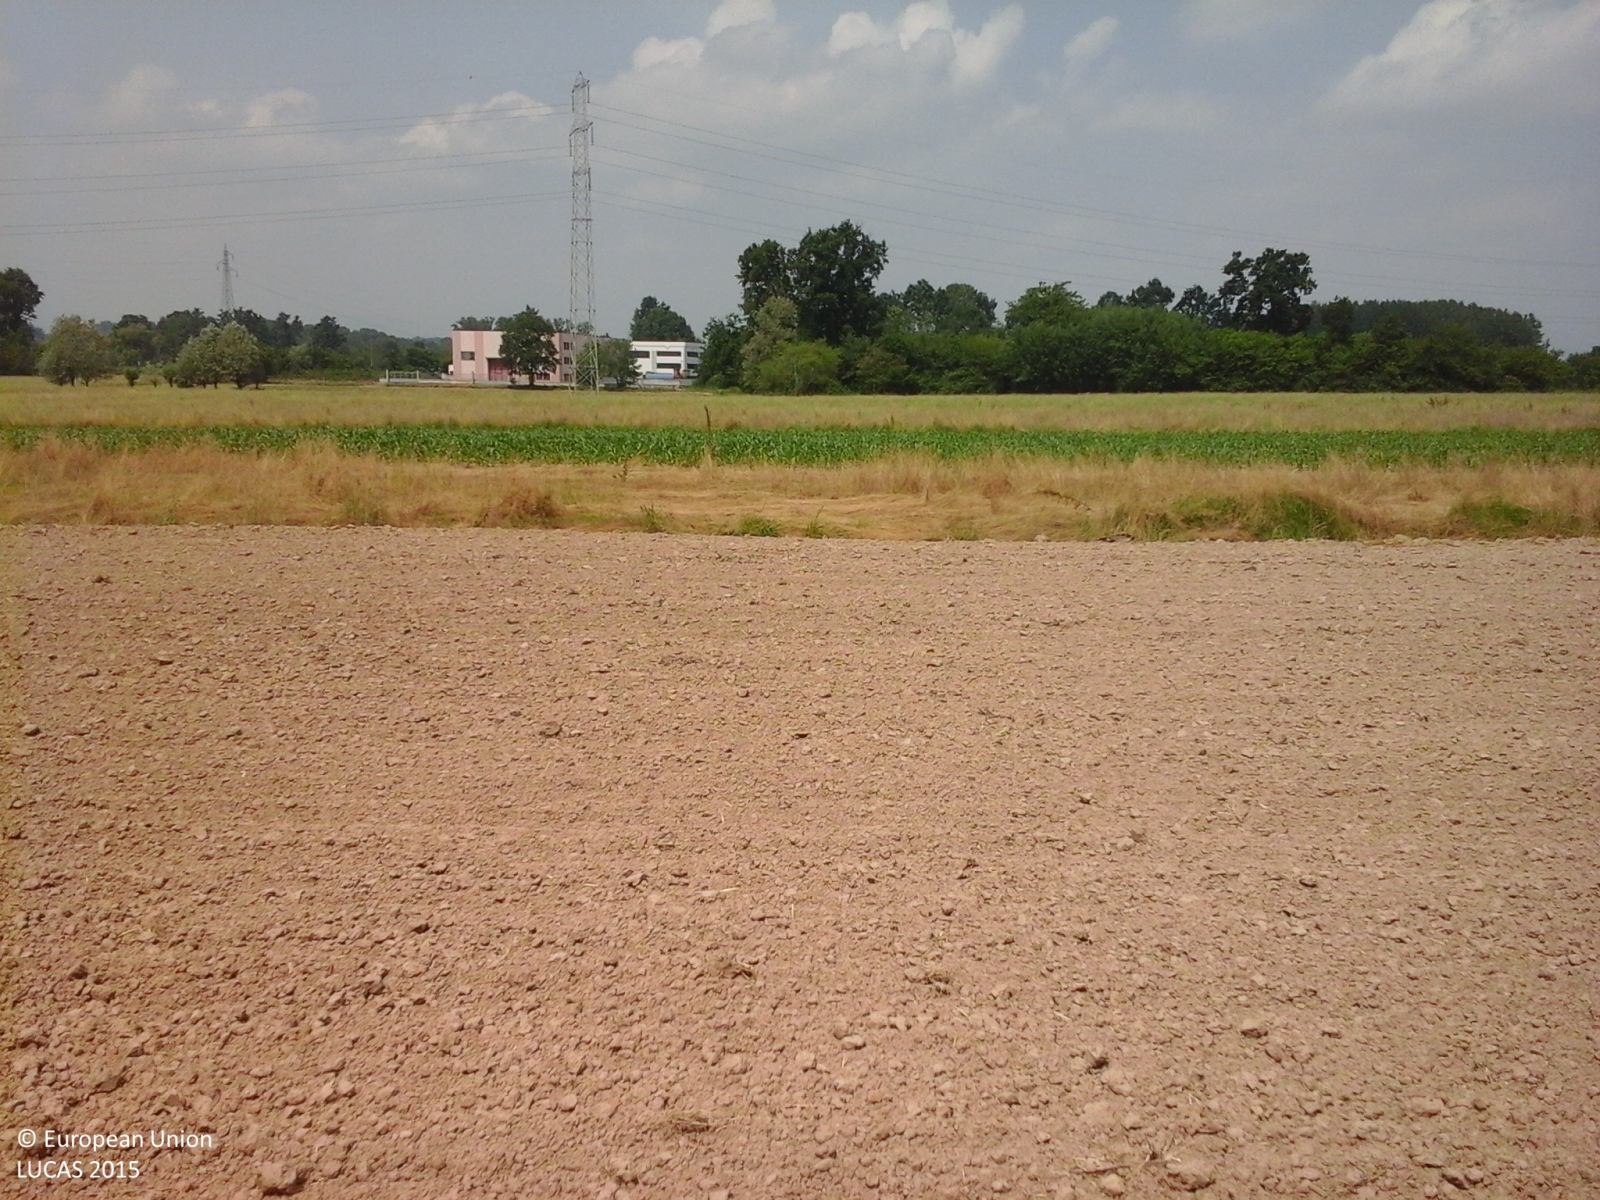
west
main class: Cropland
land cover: Soya
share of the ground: > 75 %
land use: Agriculture (excluding fallow land and kitchen gardens)
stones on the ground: < 10 %
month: May
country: IT
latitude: 45.2460
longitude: 7.7487
